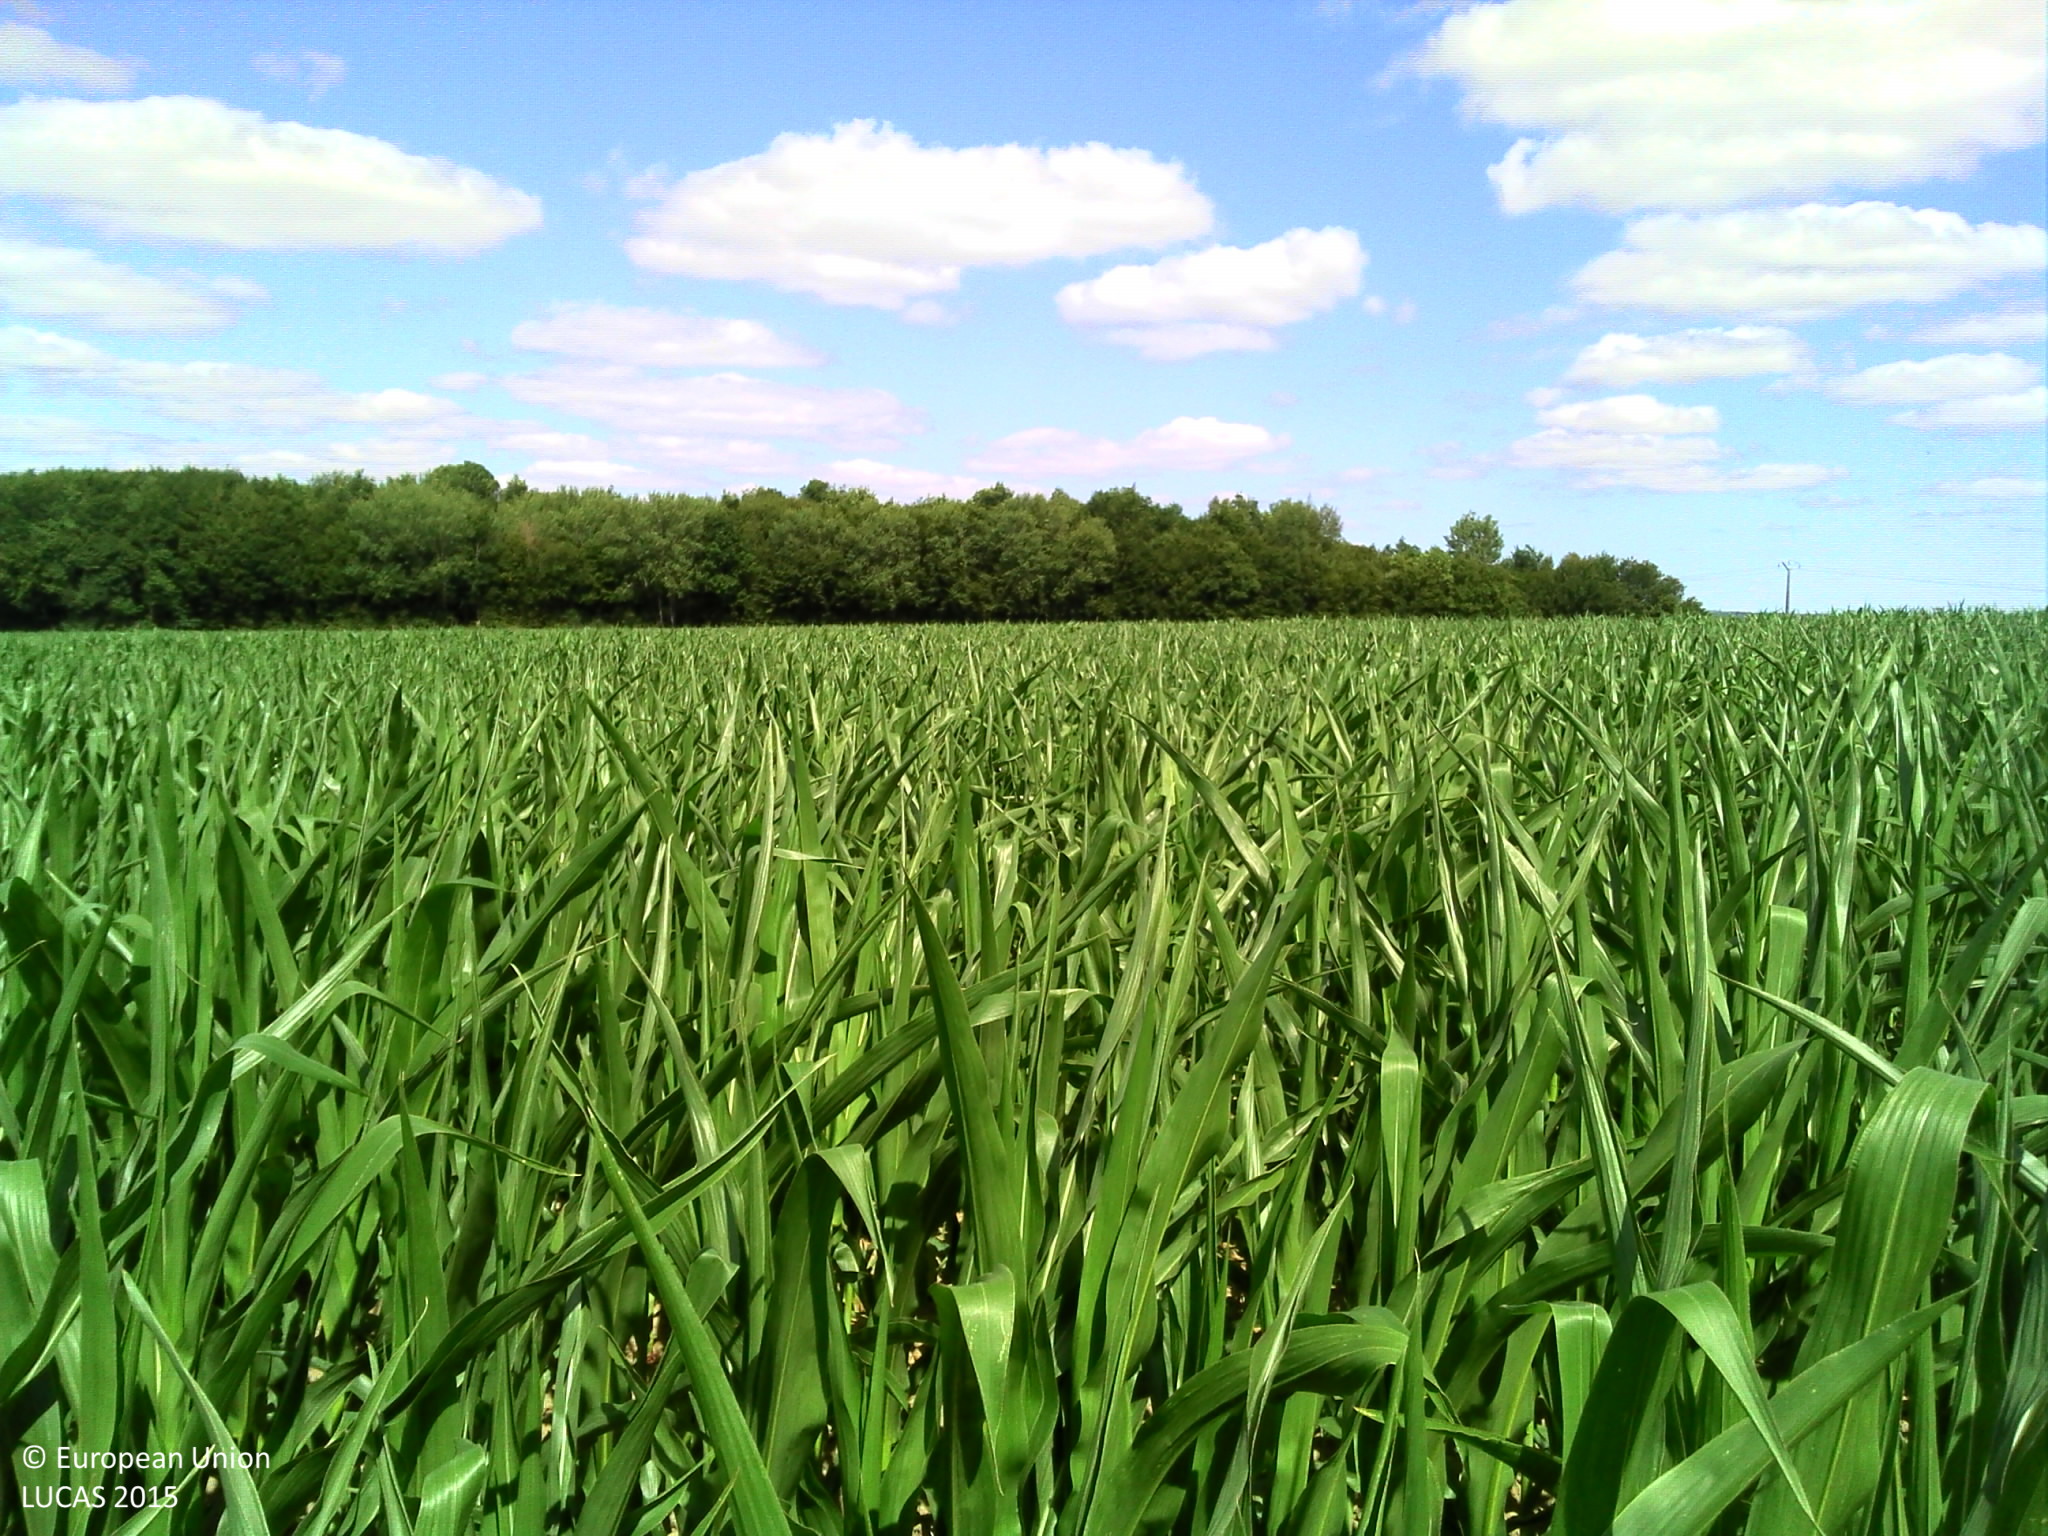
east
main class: Cropland
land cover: Maize
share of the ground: > 75 %
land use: Agriculture (excluding fallow land and kitchen gardens)
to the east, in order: Maize; Grass margins; Fences; Broadleaved woodland; Electric lines; Broadleaved woodland
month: July
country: FR
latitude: 46.3193
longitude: 1.7187
